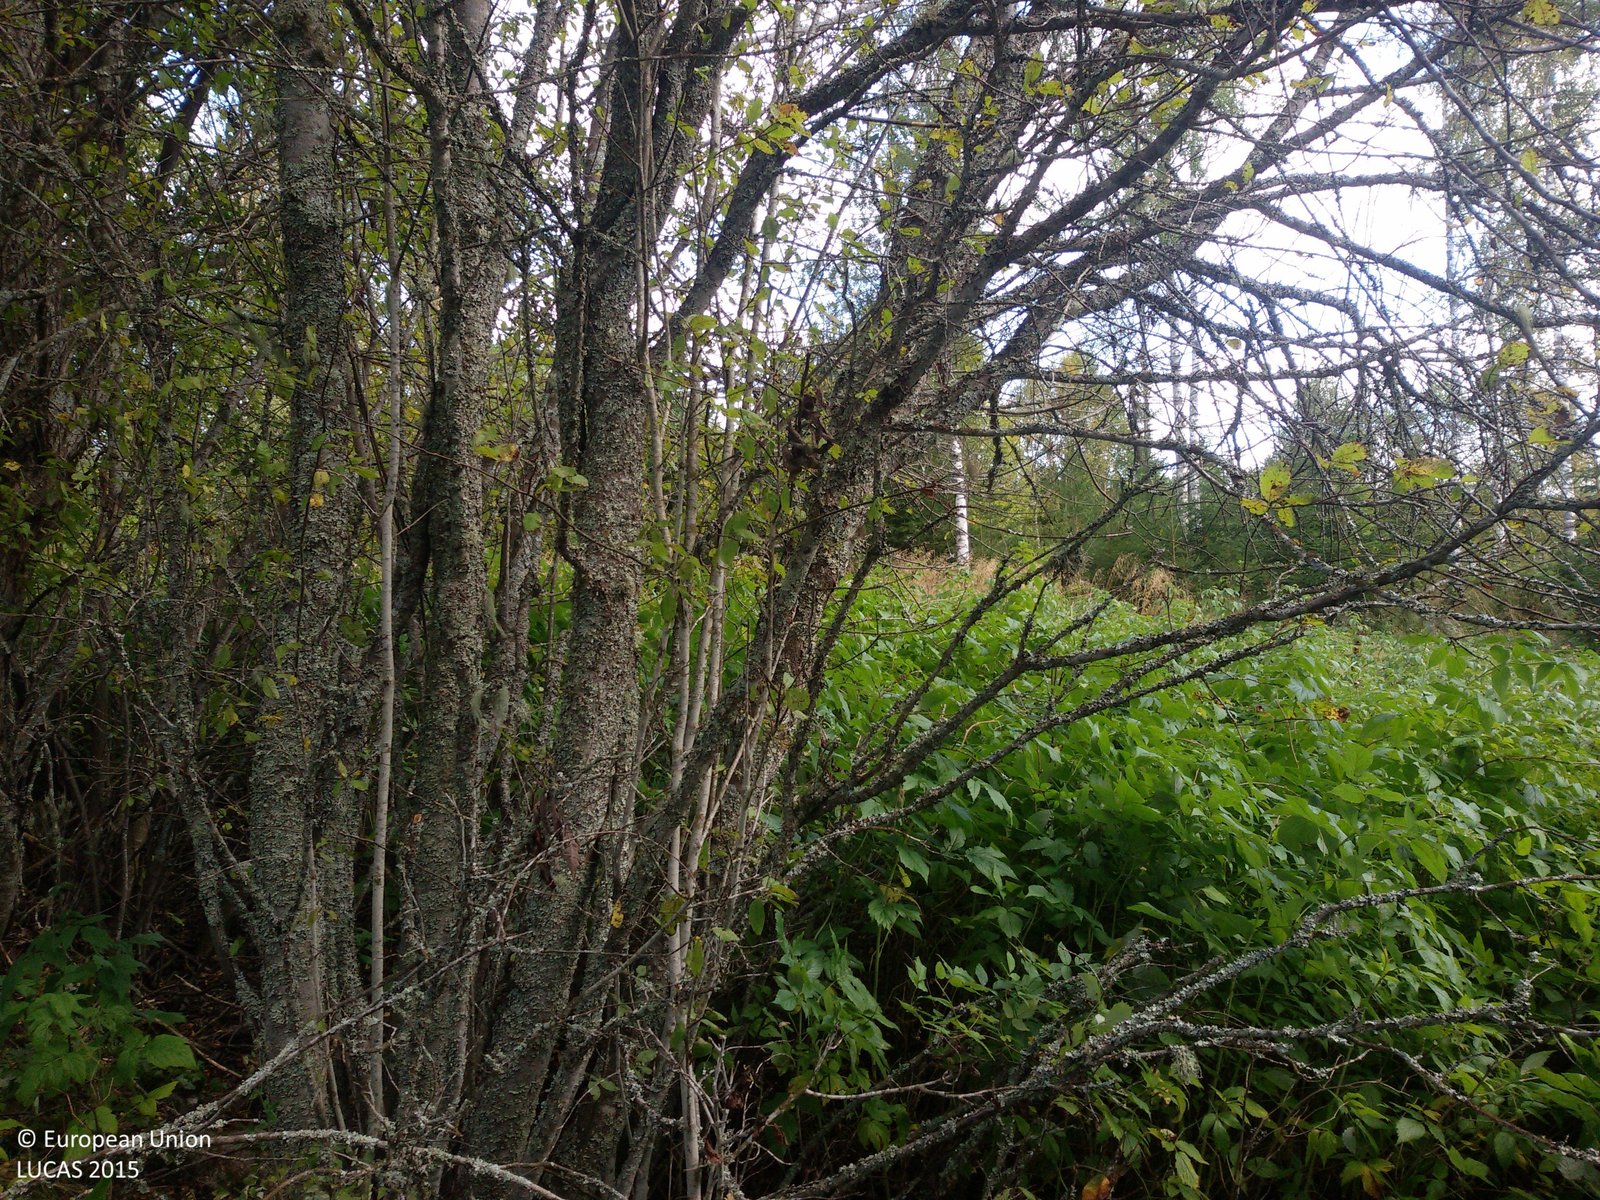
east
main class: Woodland
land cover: Broadleaved woodland
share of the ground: > 75 %
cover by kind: broadleaved forest trees 80 %, herbaceous plants 20 %
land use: Semi-natural and natural areas not in use
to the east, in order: Broadleaved woodland; Spontaneously vegetated surfaces; Broadleaved woodland; Ditches and canals; Paved roads, cycling and walking lanes; Ditches and canals; Broadleaved woodland; Spruce dominated coniferous woodland
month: September
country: SE
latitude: 60.7546
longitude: 15.1431
